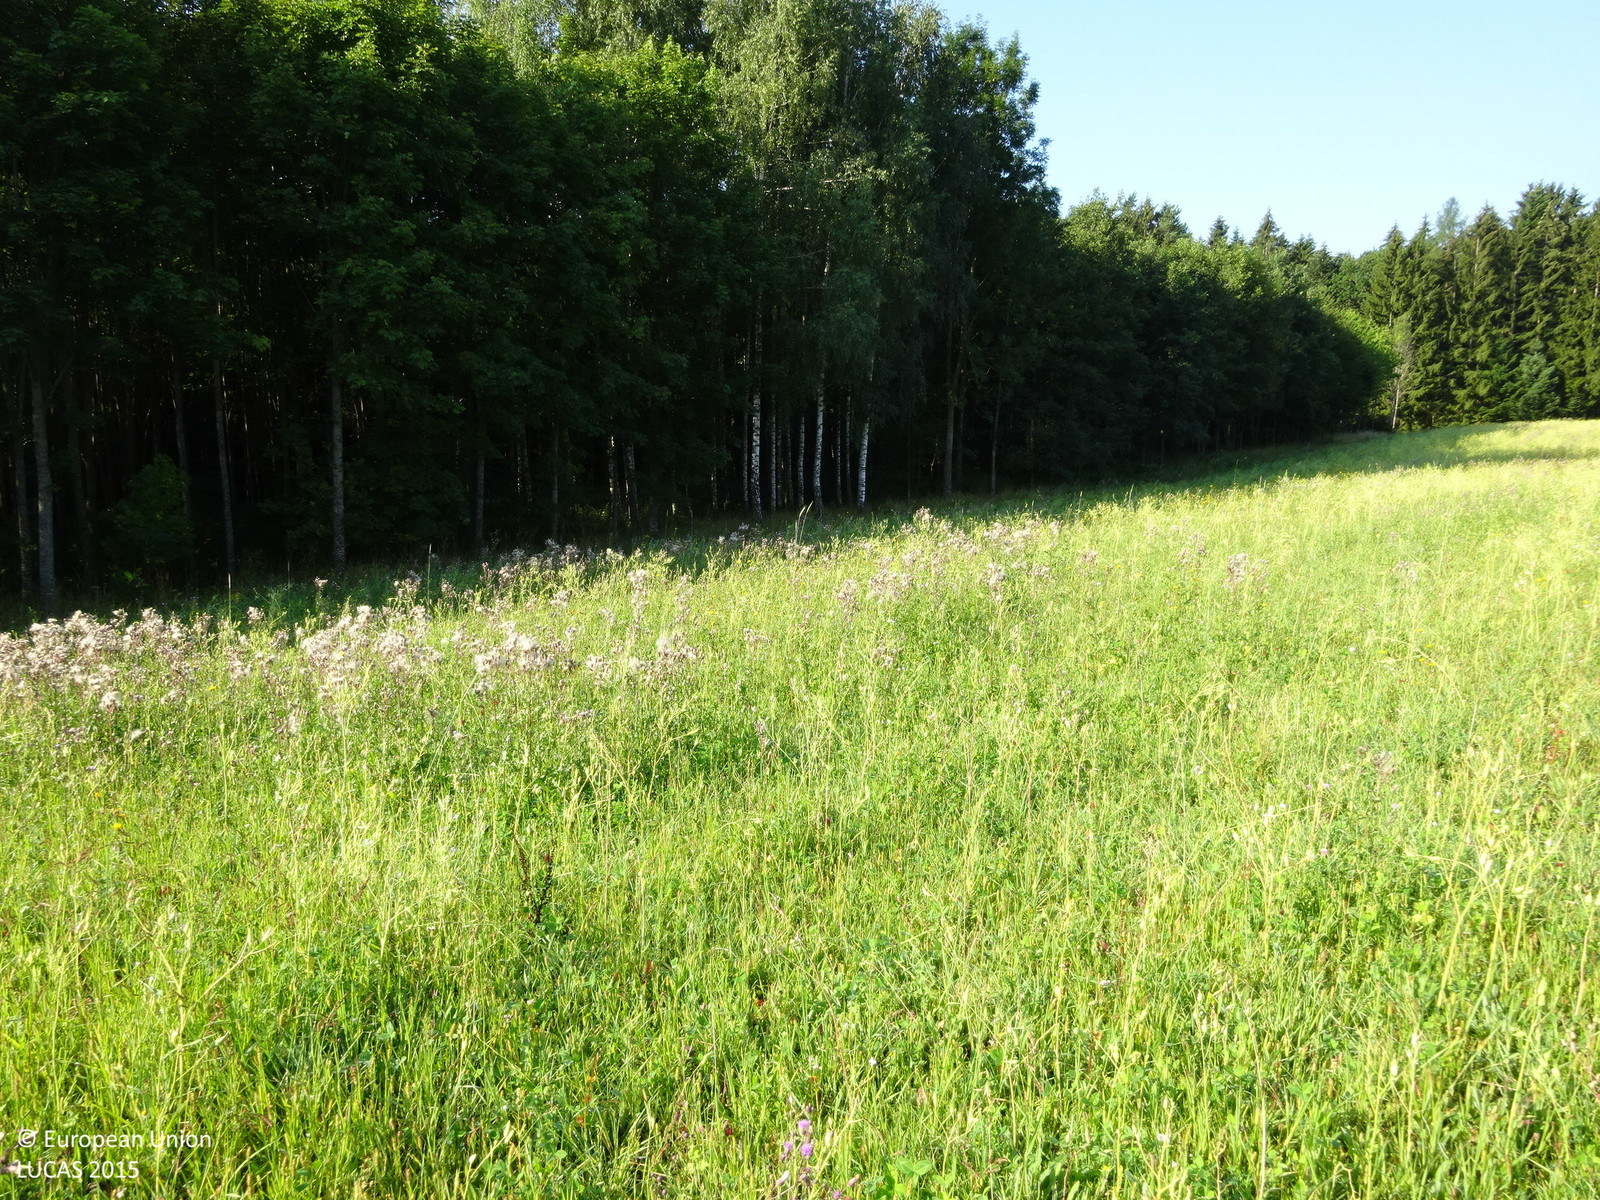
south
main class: Grassland
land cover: Grassland without tree/shrub cover
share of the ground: > 75 %
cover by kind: herbaceous plants 100 %
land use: Agriculture (excluding fallow land and kitchen gardens)
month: August
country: AT
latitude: 47.3908
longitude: 16.0298
